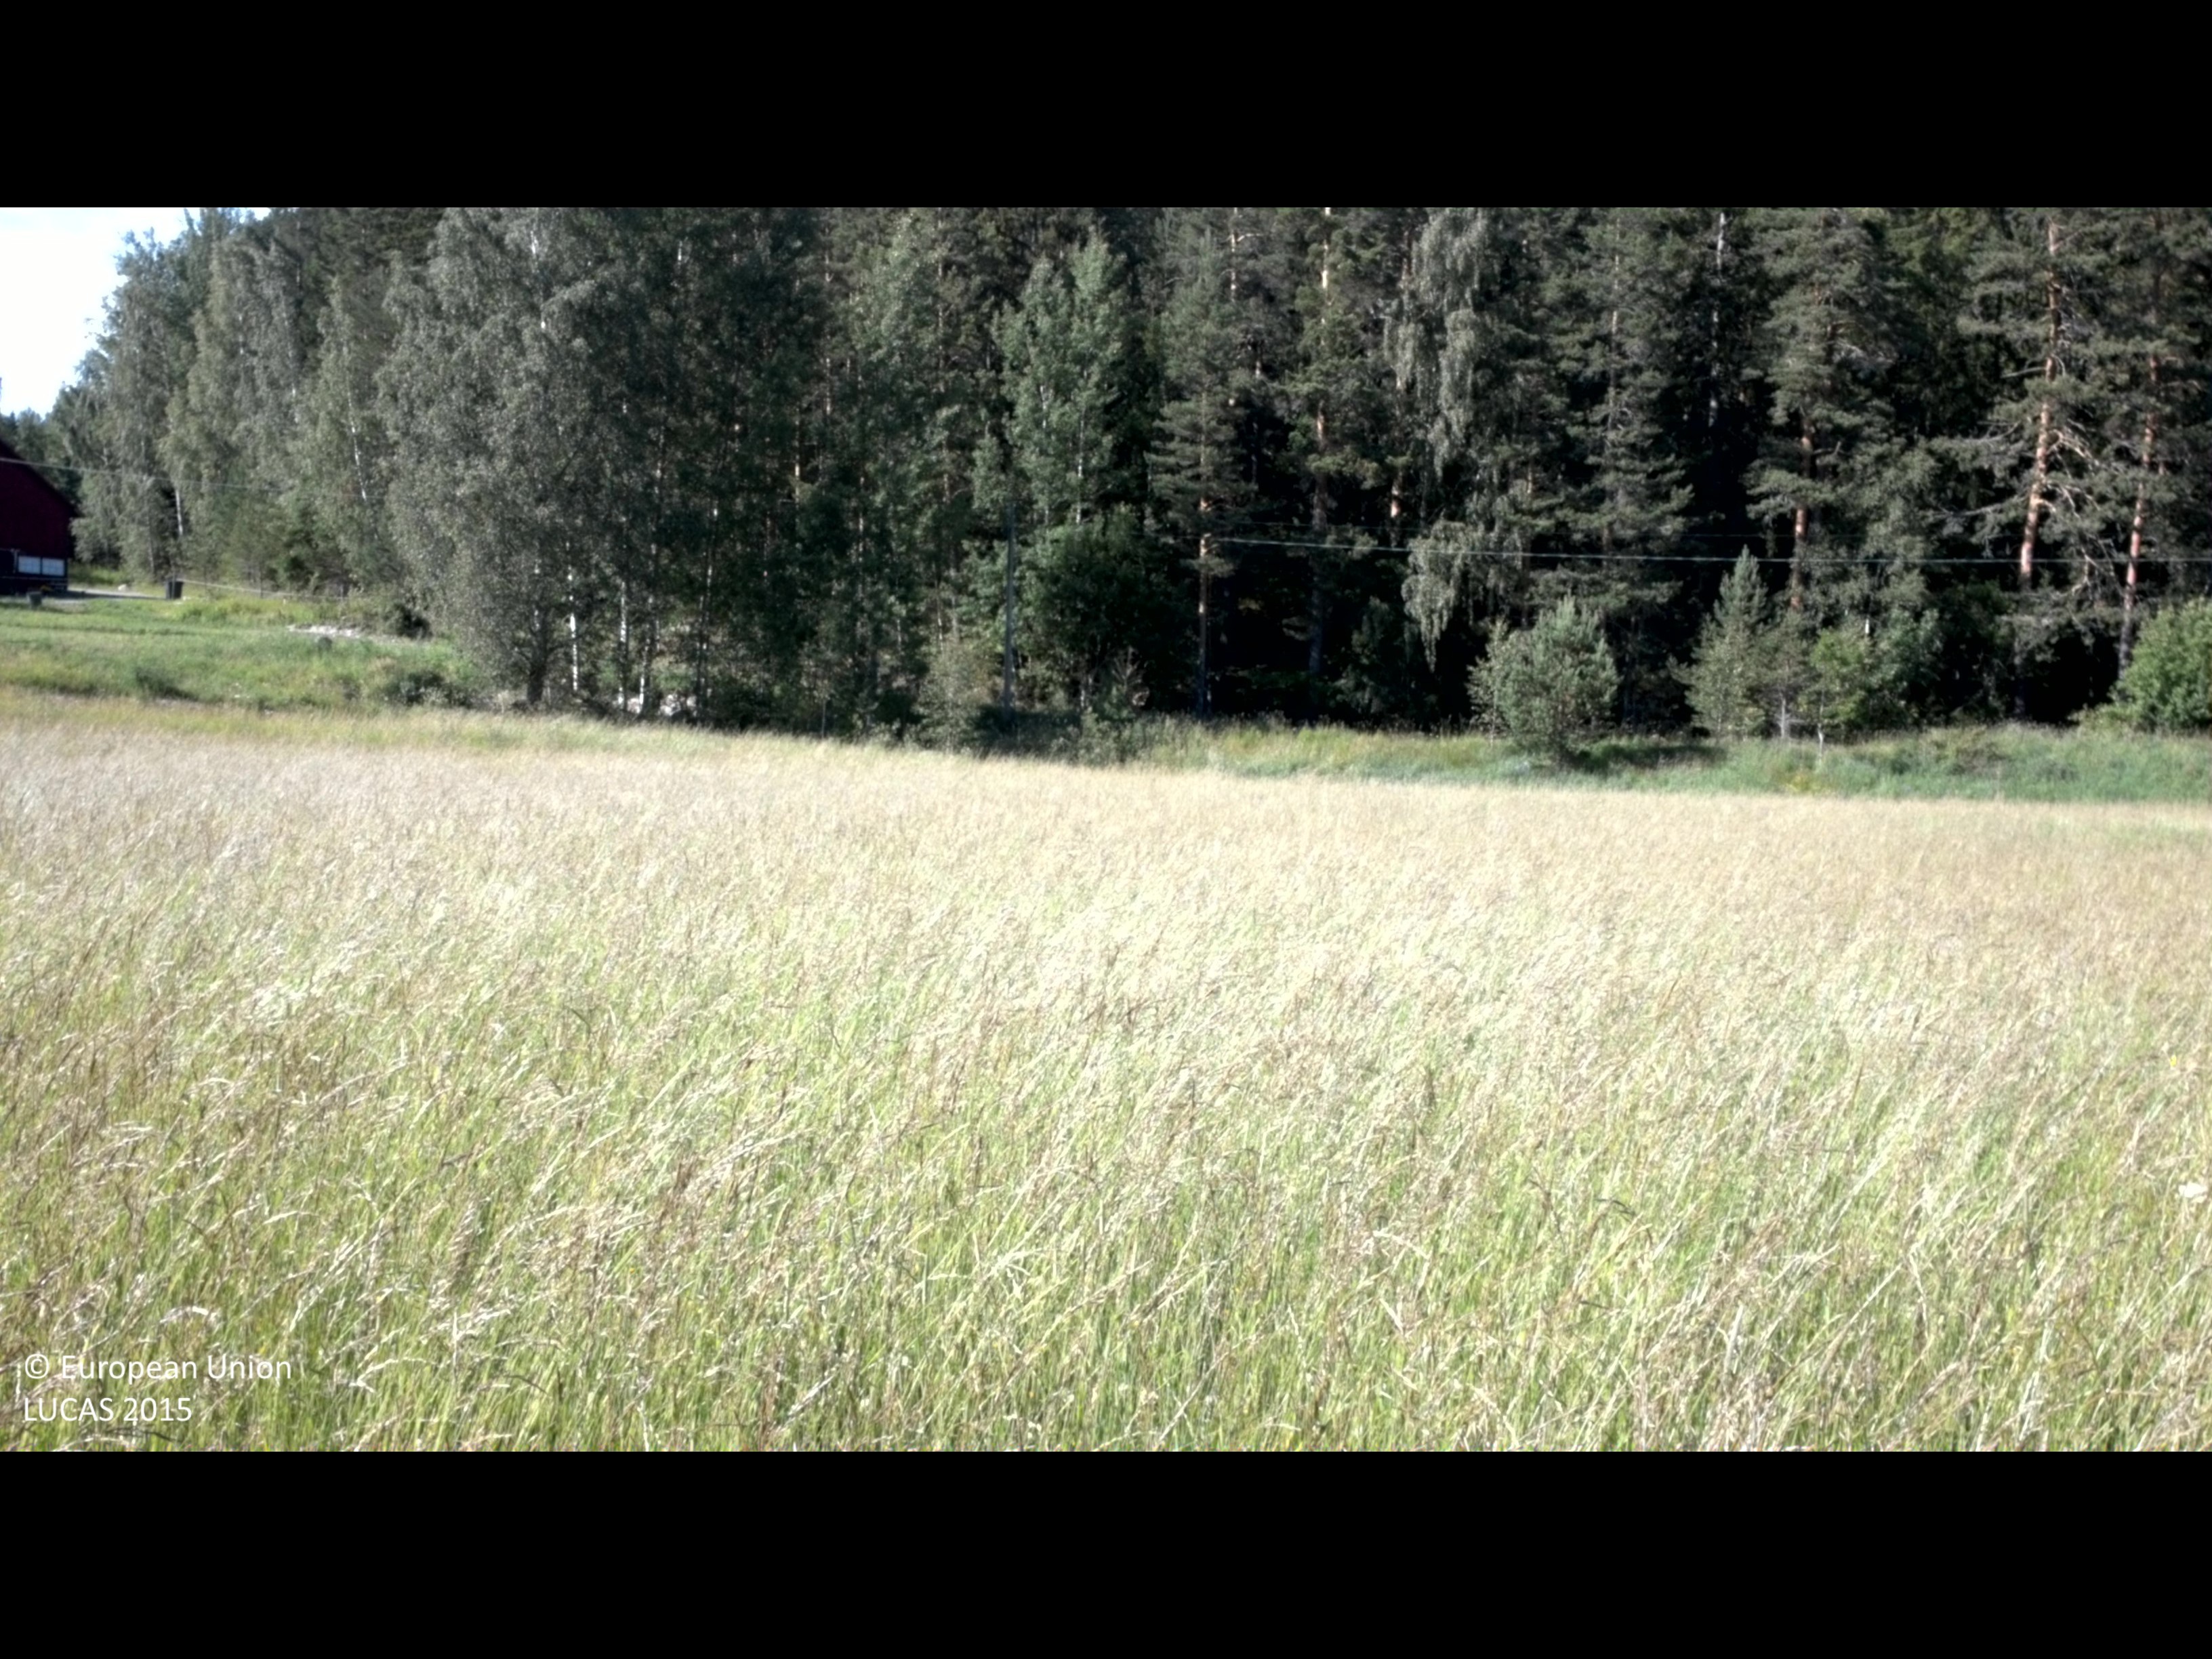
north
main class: Cropland
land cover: Other leguminous and mixtures for fodder
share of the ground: > 75 %
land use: Agriculture (excluding fallow land and kitchen gardens)
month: June
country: SE
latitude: 58.2235
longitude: 16.1423
